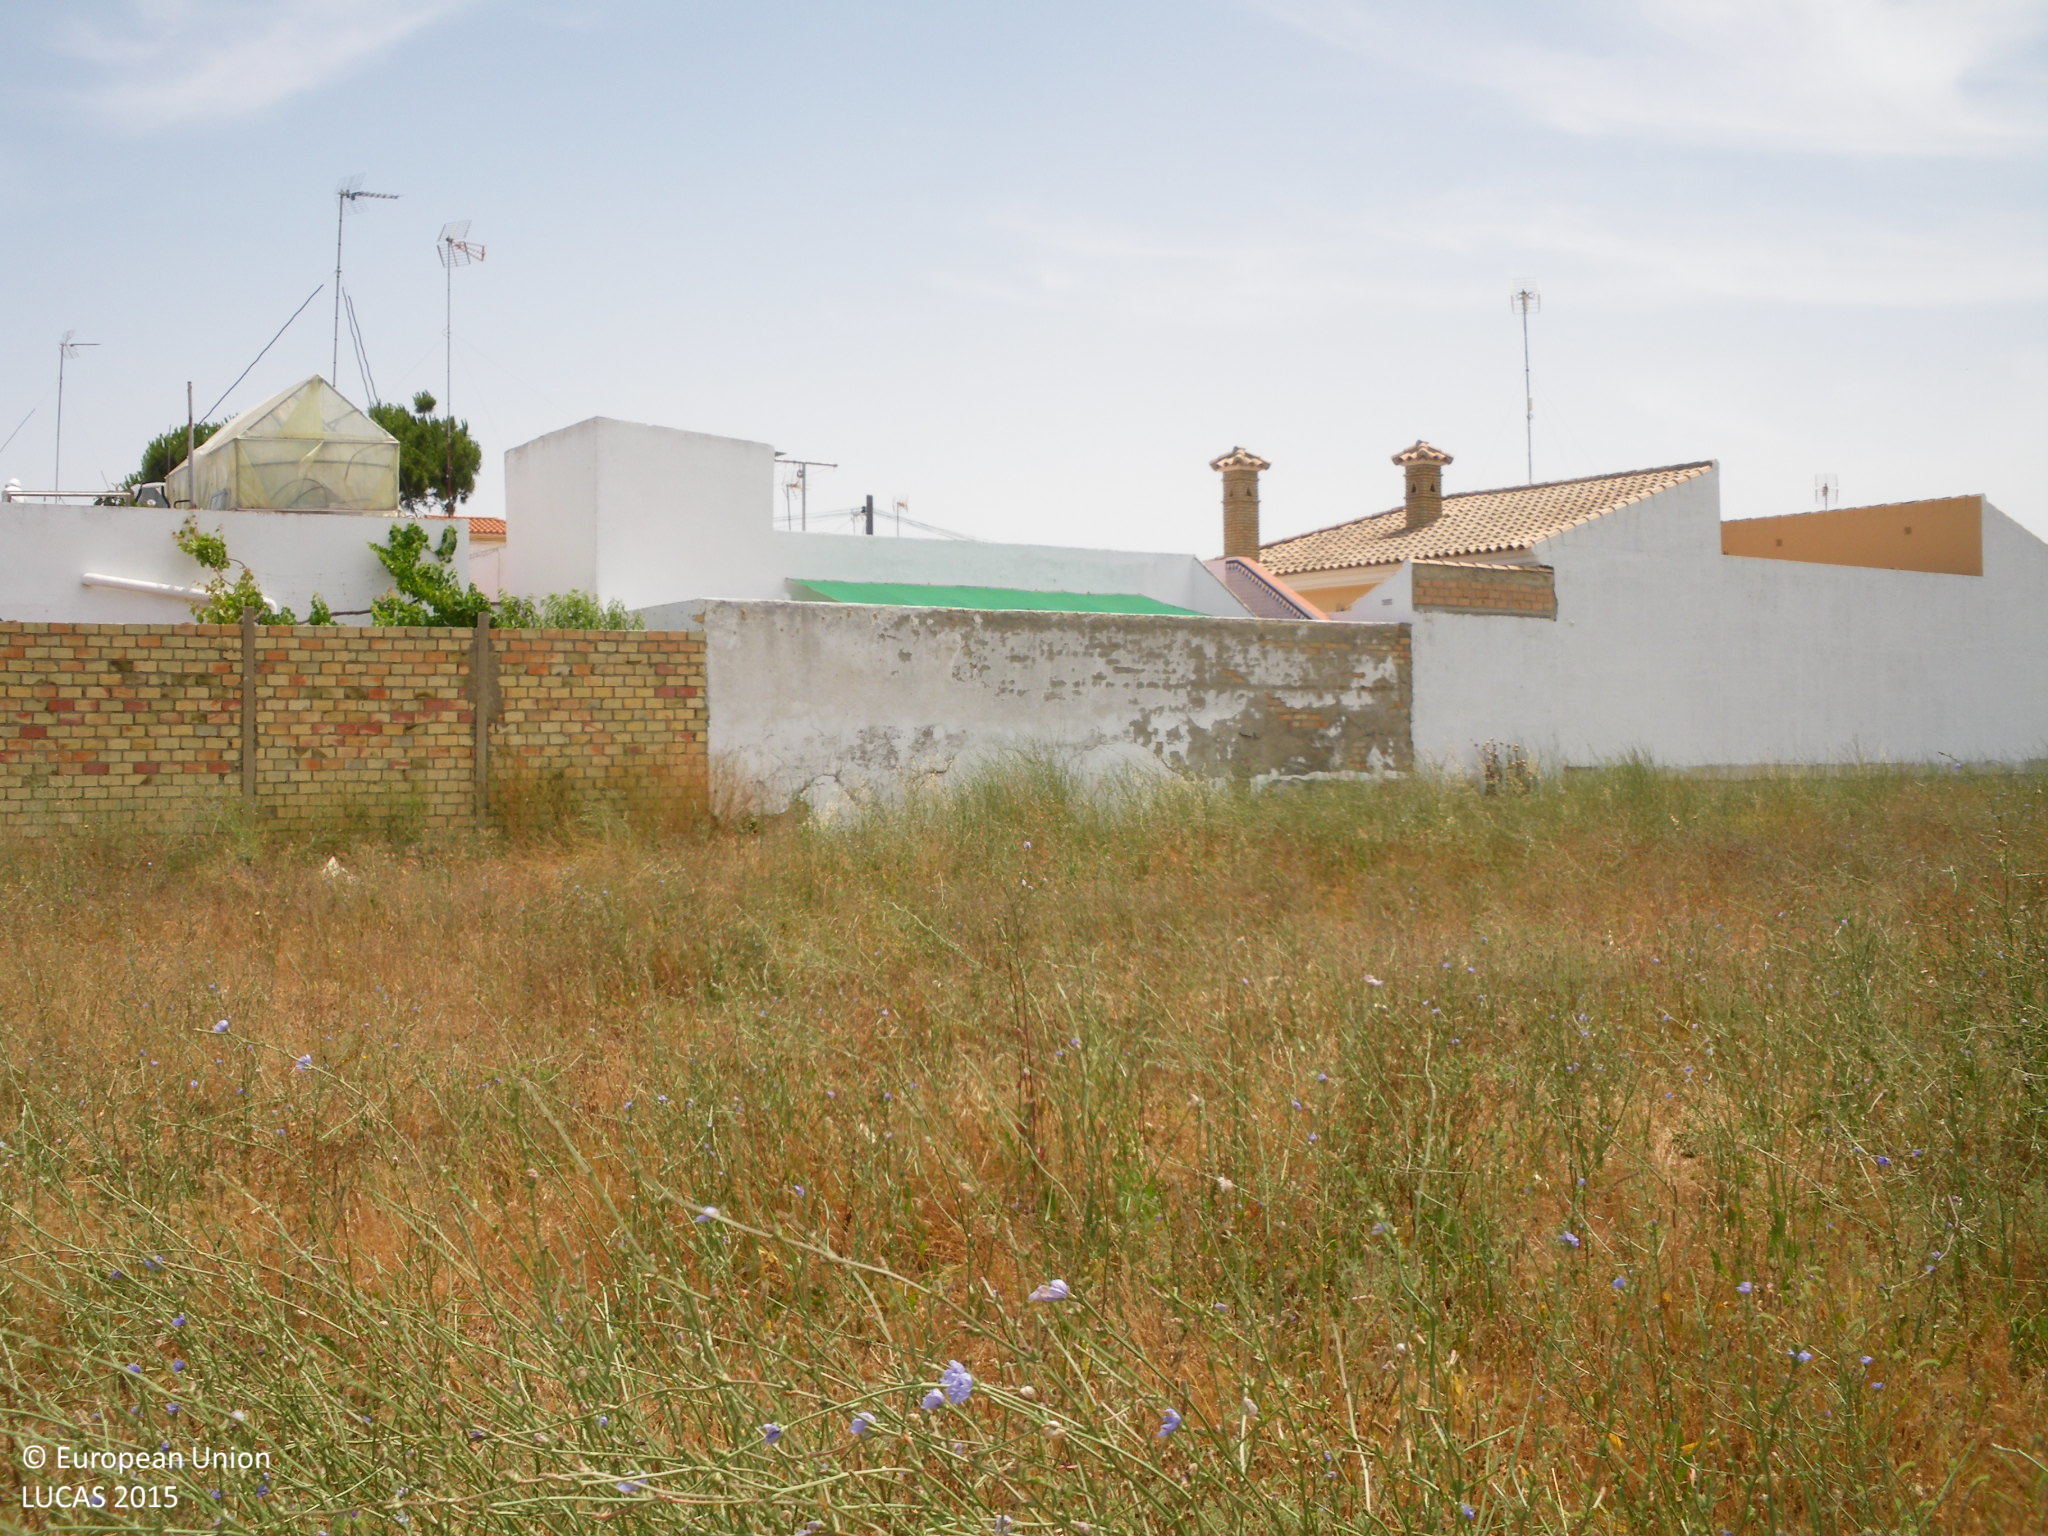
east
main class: Grassland
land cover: Grassland without tree/shrub cover
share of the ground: > 75 %
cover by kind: herbaceous plants 95 %, unconsolidated bare surface 5 %
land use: Agriculture (excluding fallow land and kitchen gardens)
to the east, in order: Grassland without tree/shrub cover; Artificial constructions in urban areas
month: June
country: ES
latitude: 36.7337
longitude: -6.4231
